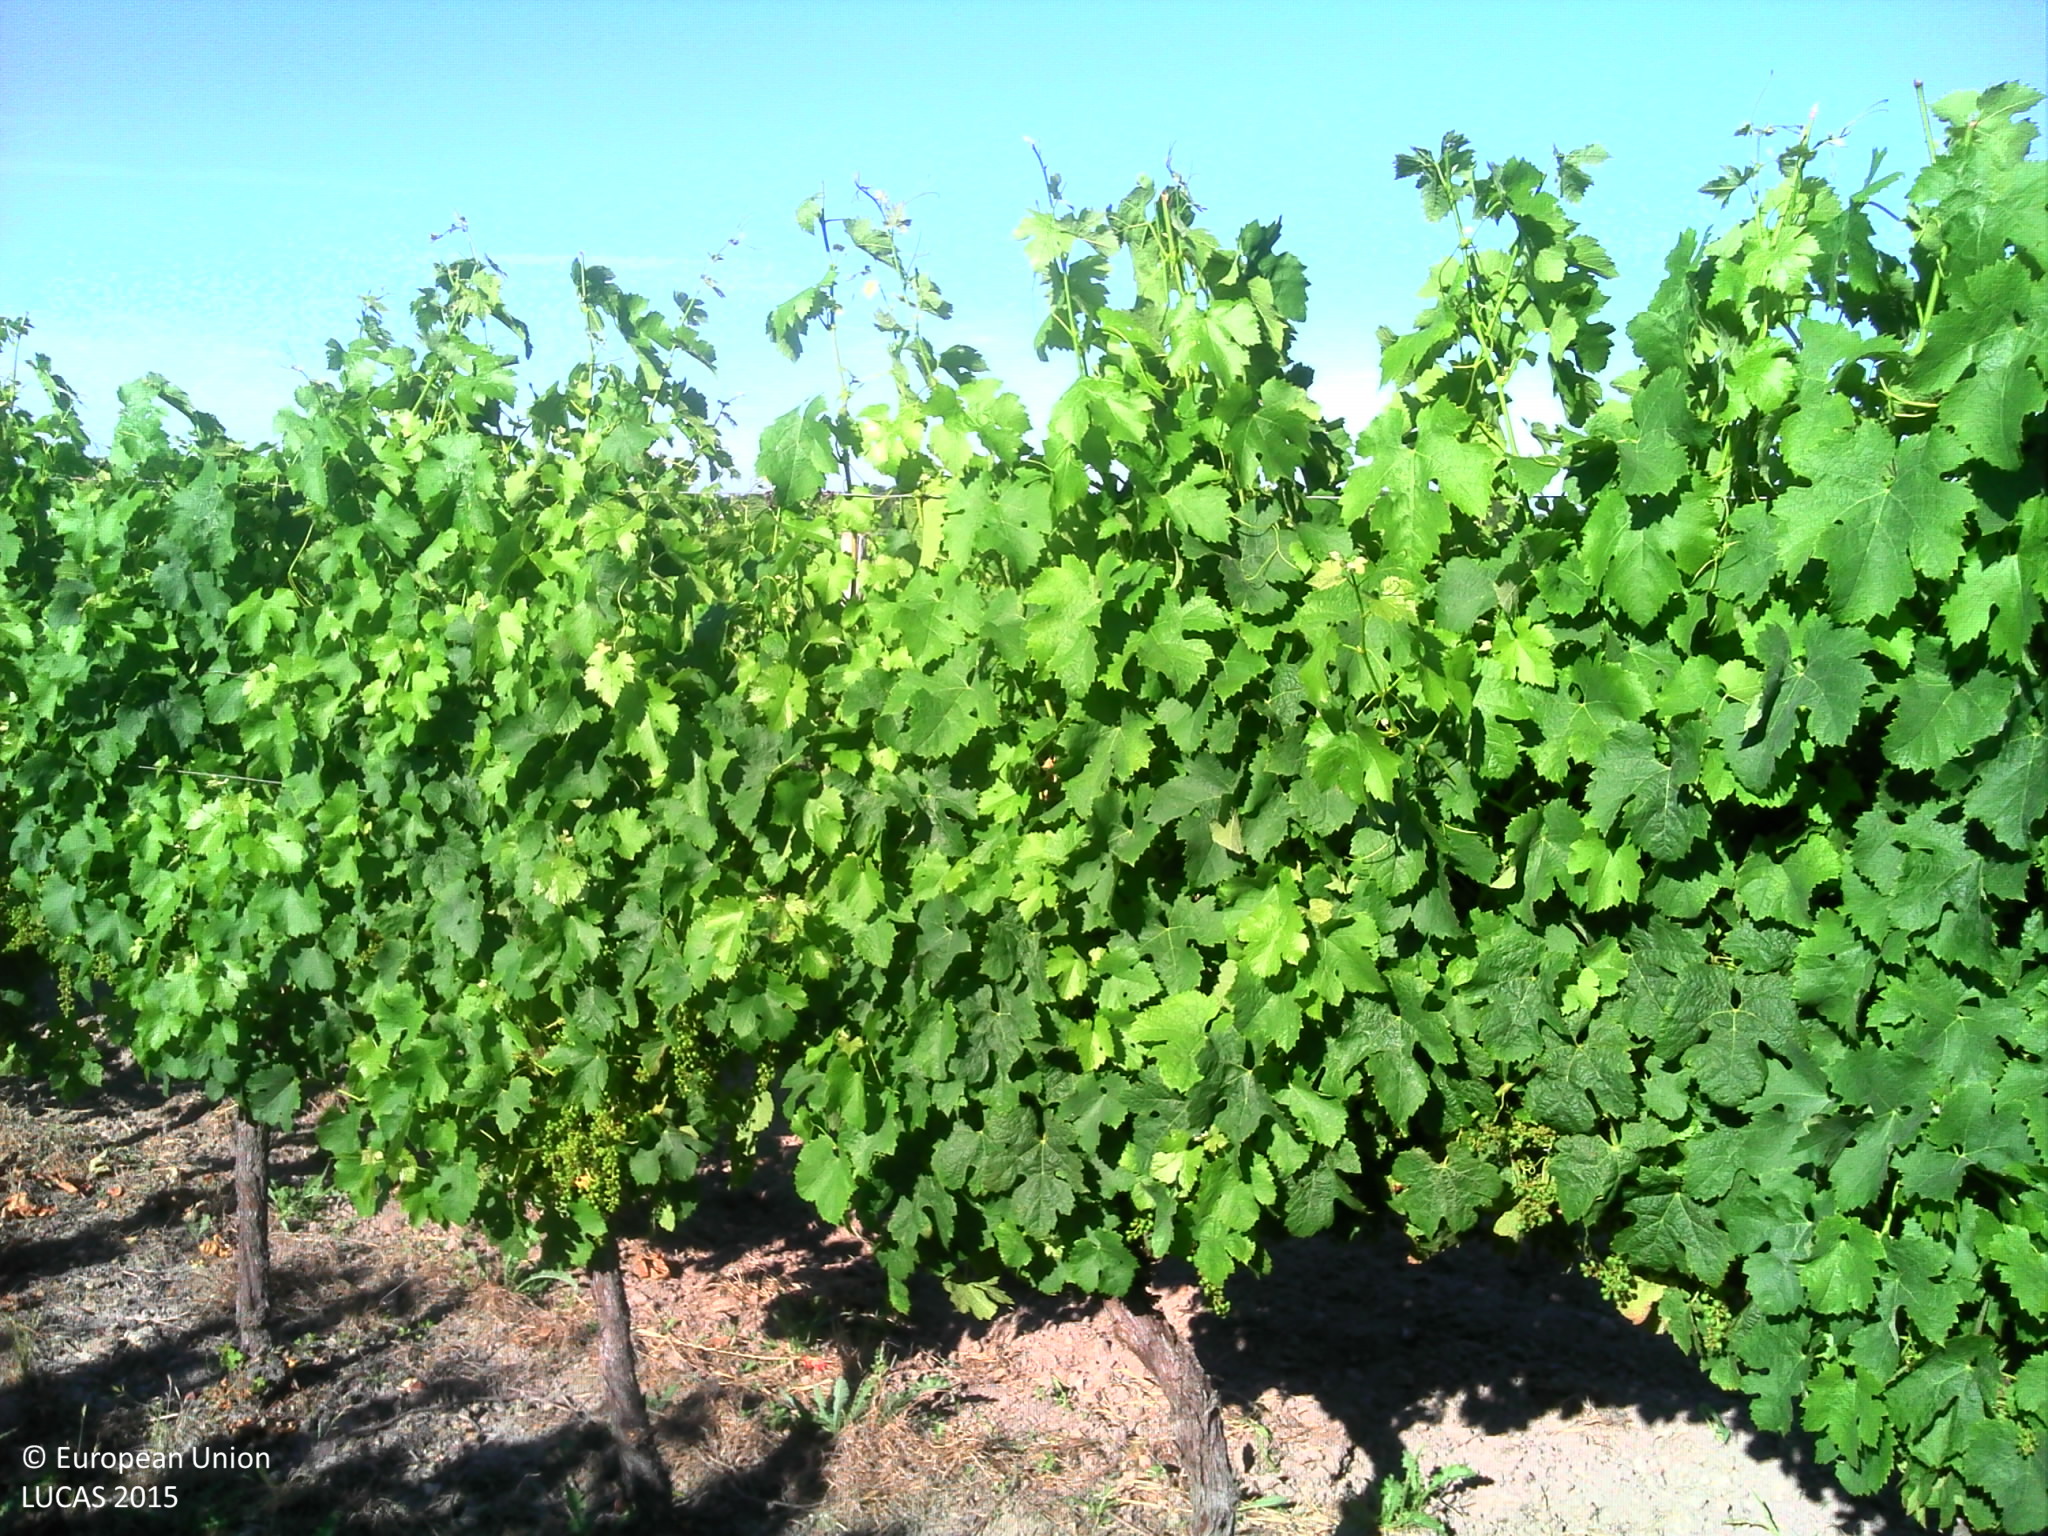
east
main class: Cropland
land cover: Vineyards
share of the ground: 25 - 50 %
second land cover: Grassland without tree/shrub cover
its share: 50 - 75 %
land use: Agriculture (excluding fallow land and kitchen gardens)
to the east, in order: Vineyards; Grassland without tree/shrub cover
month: June
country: FR
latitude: 45.5843
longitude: -0.8039
